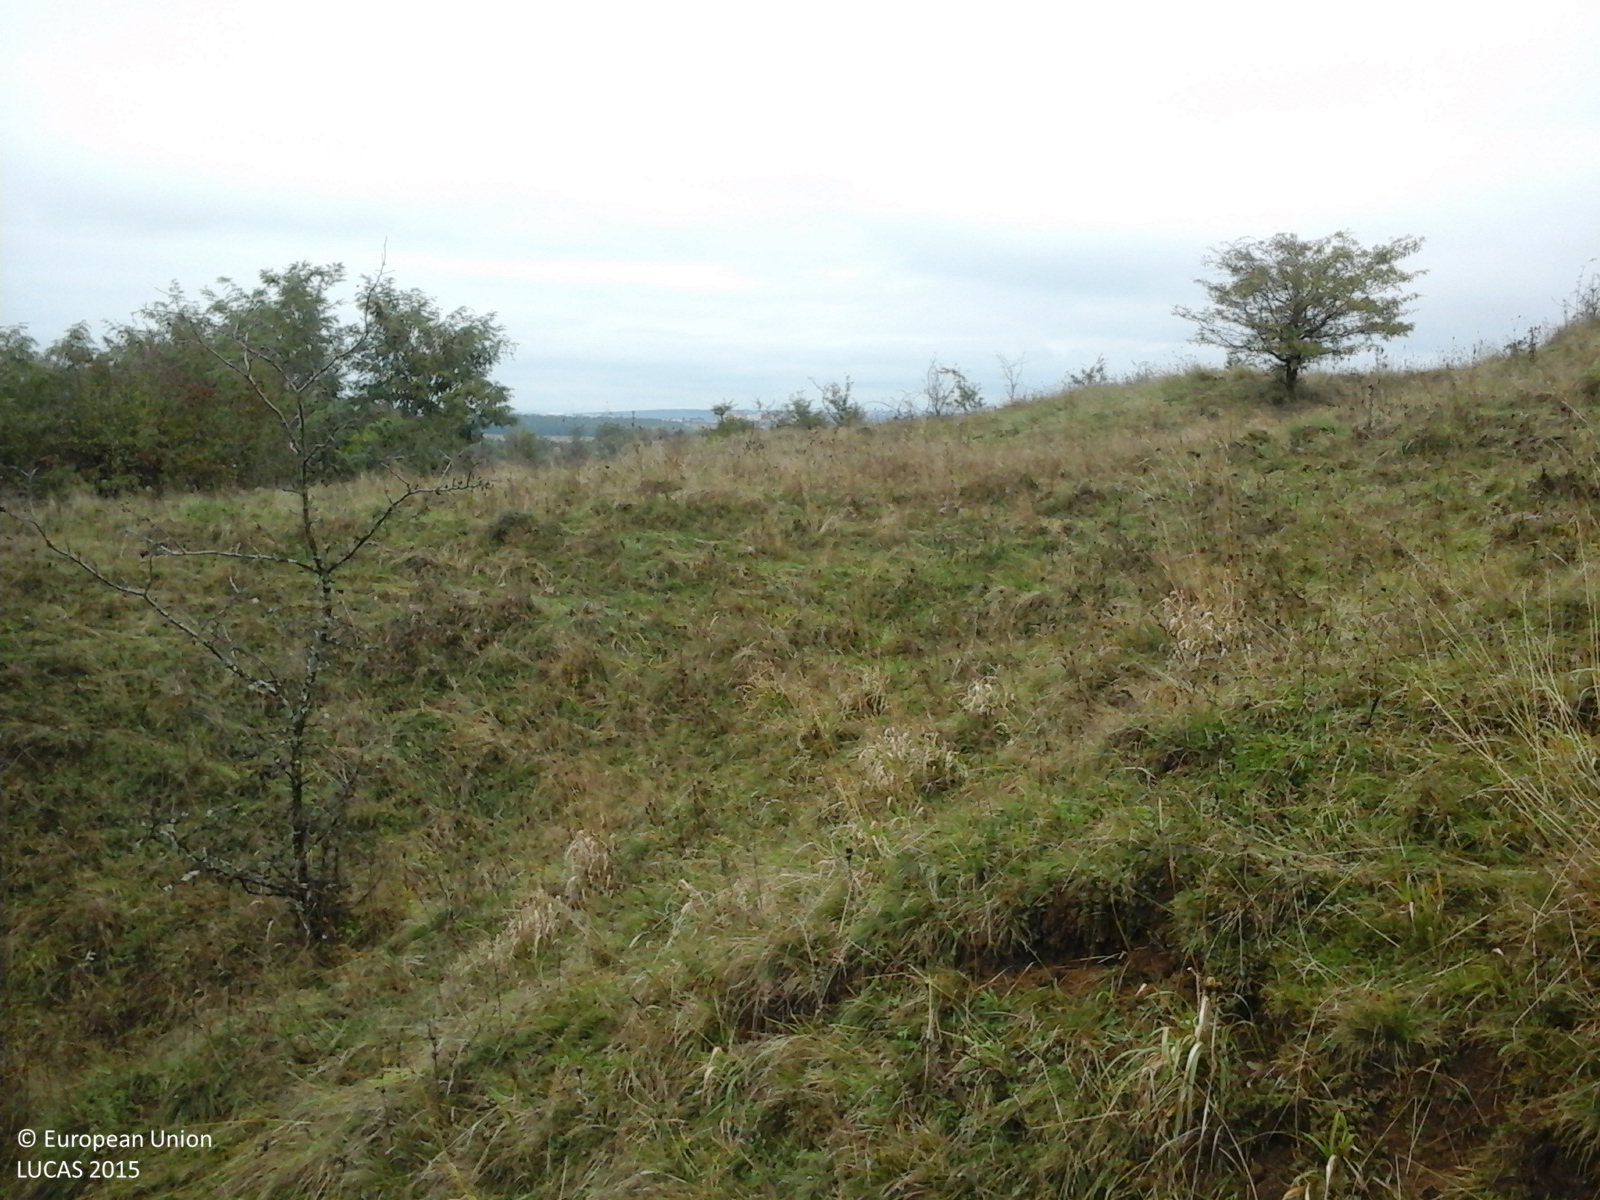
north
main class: Grassland
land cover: Grassland with sparse tree/shrub cover
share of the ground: > 75 %
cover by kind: herbaceous plants 95 %, broadleaved forest trees 5 %
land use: Agriculture (excluding fallow land and kitchen gardens)
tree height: < 5 m
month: October
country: RO
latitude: 45.7587
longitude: 24.1003
